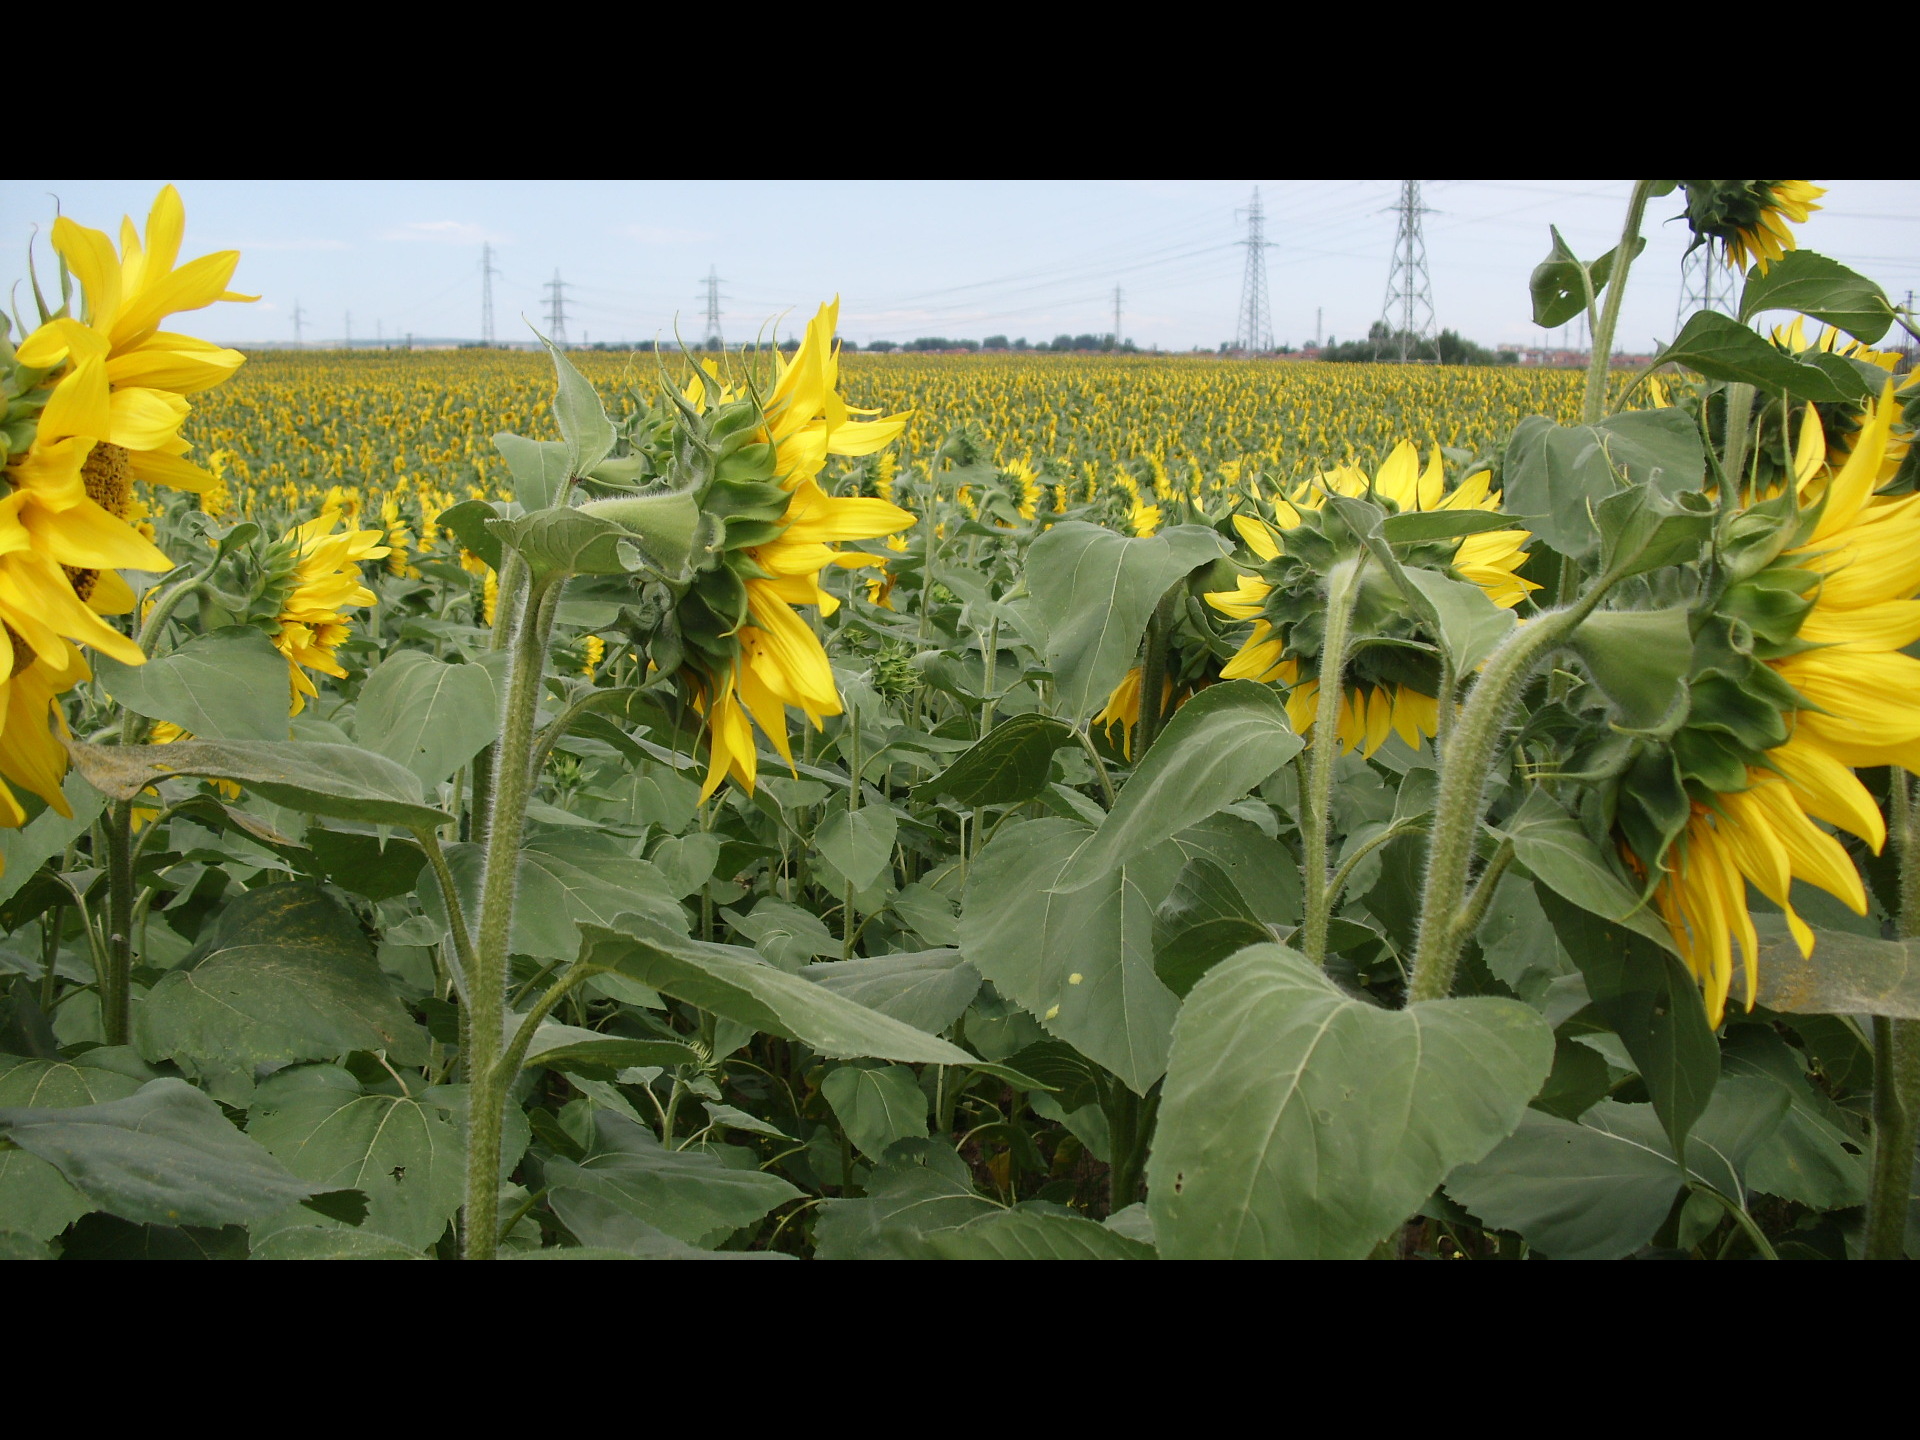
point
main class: Cropland
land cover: Sunflower
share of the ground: > 75 %
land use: Agriculture (excluding fallow land and kitchen gardens)
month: July
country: BG
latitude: 43.9688
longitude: 22.8398
